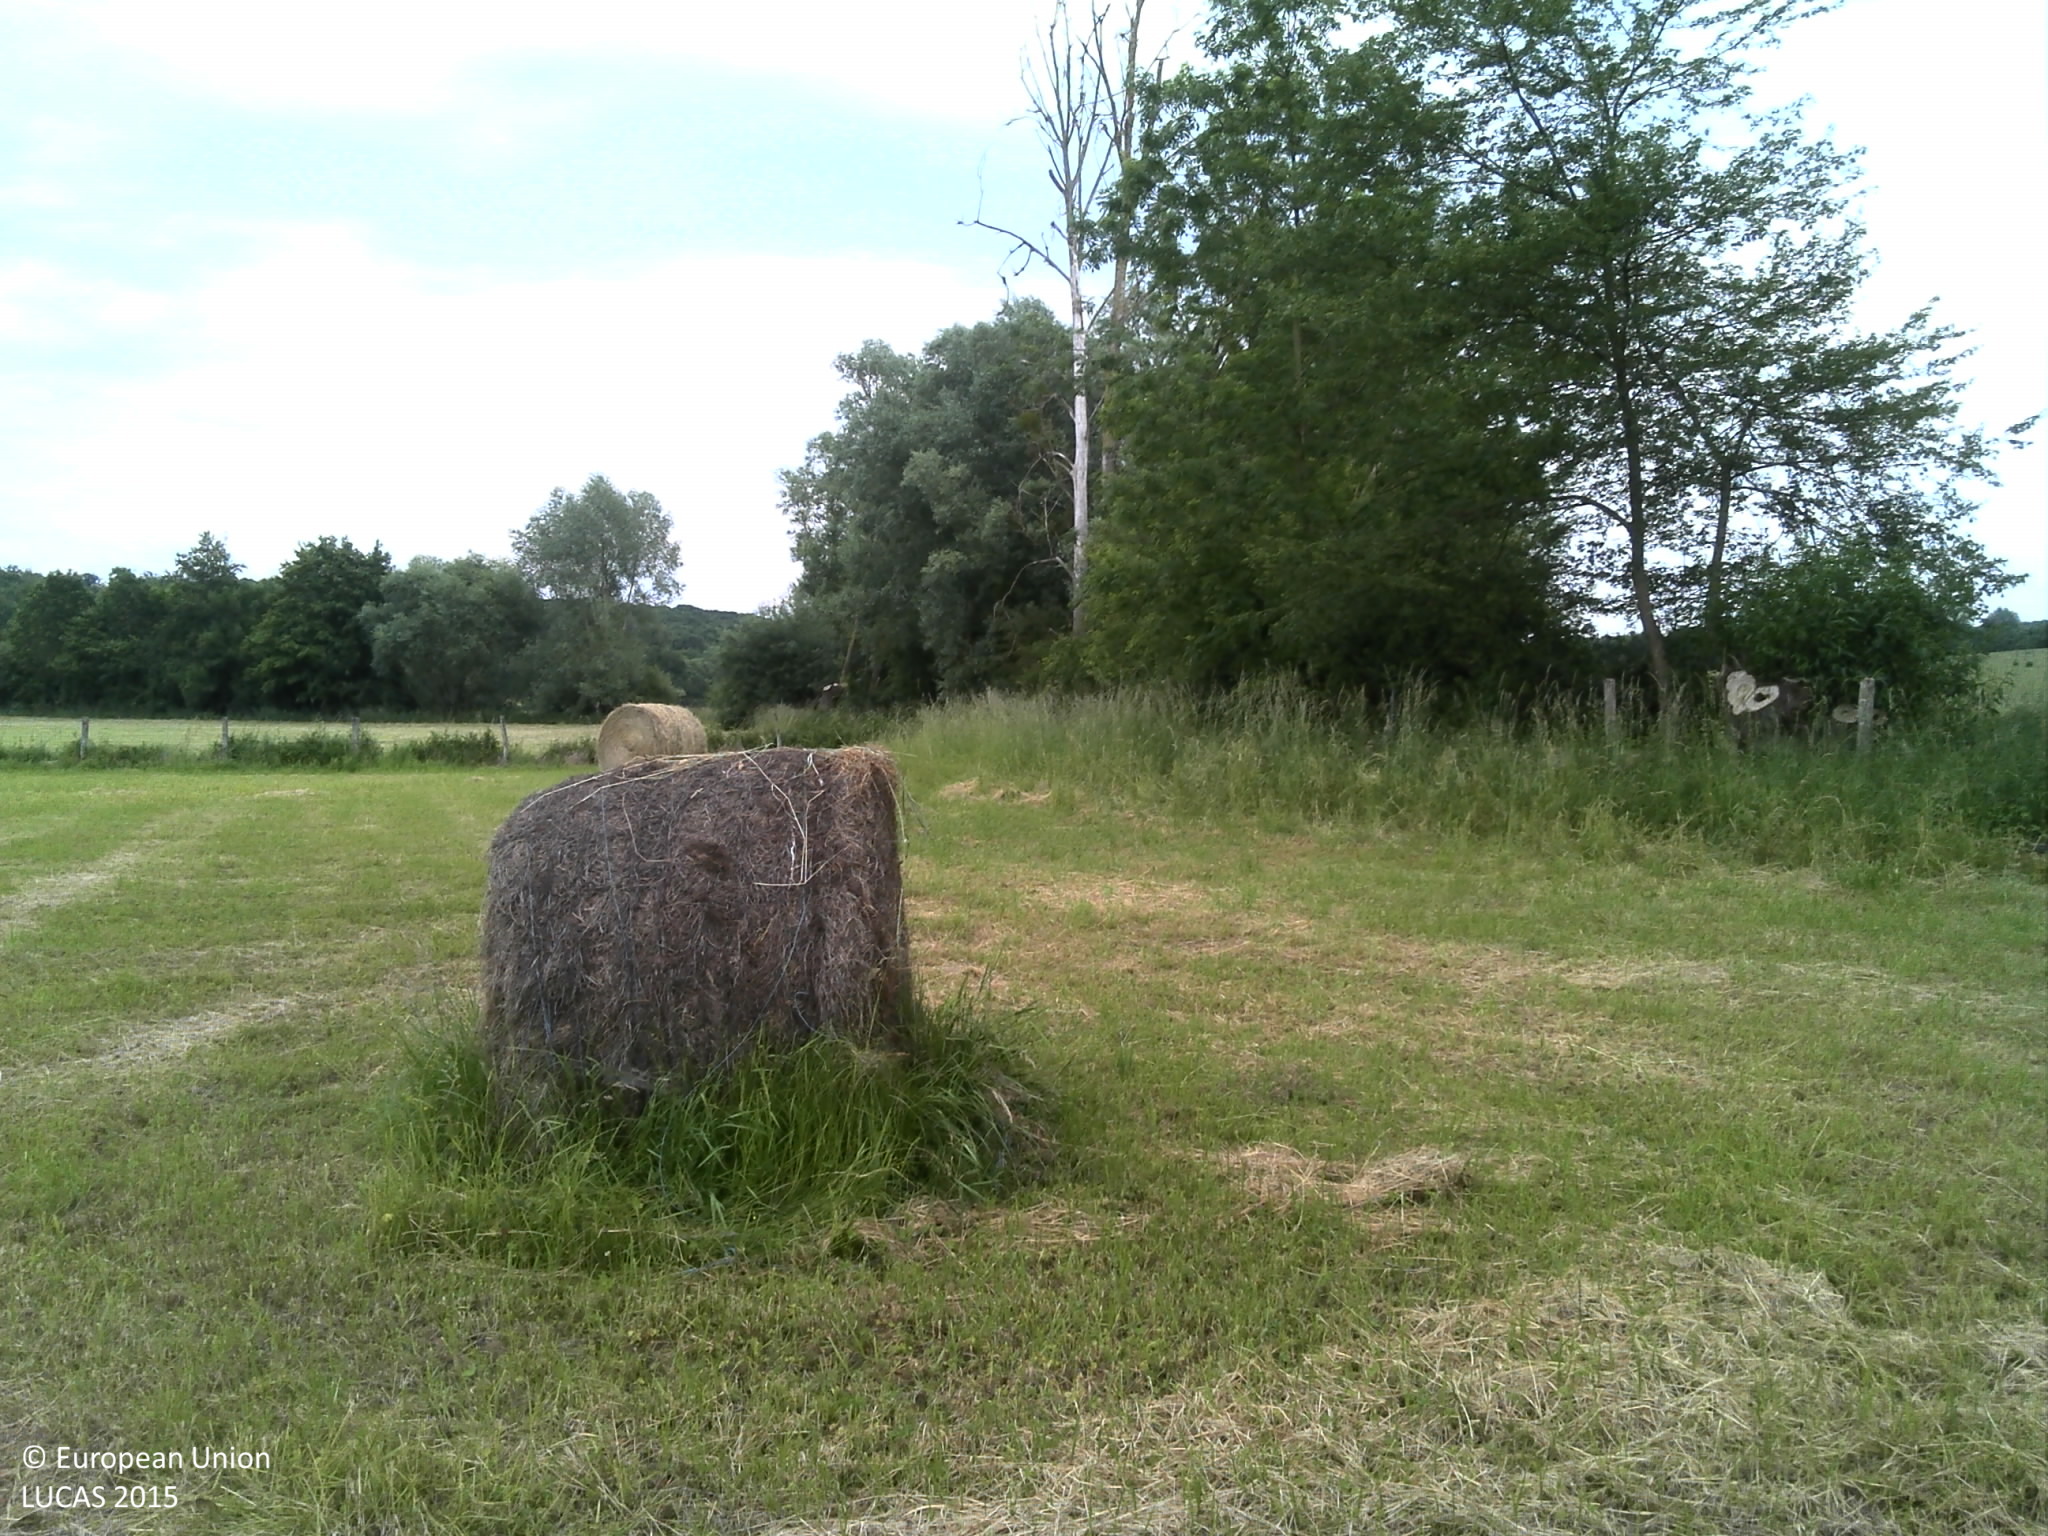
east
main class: Grassland
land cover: Grassland without tree/shrub cover
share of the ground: > 75 %
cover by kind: herbaceous plants 100 %
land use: Agriculture (excluding fallow land and kitchen gardens)
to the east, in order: Grassland without tree/shrub cover; Fences; Broadleaved woodland; Rivers and streams; Broadleaved woodland; Grassland without tree/shrub cover; Fences; Grassland without tree/shrub cover
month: June
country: FR
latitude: 49.2404
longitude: 6.2500
